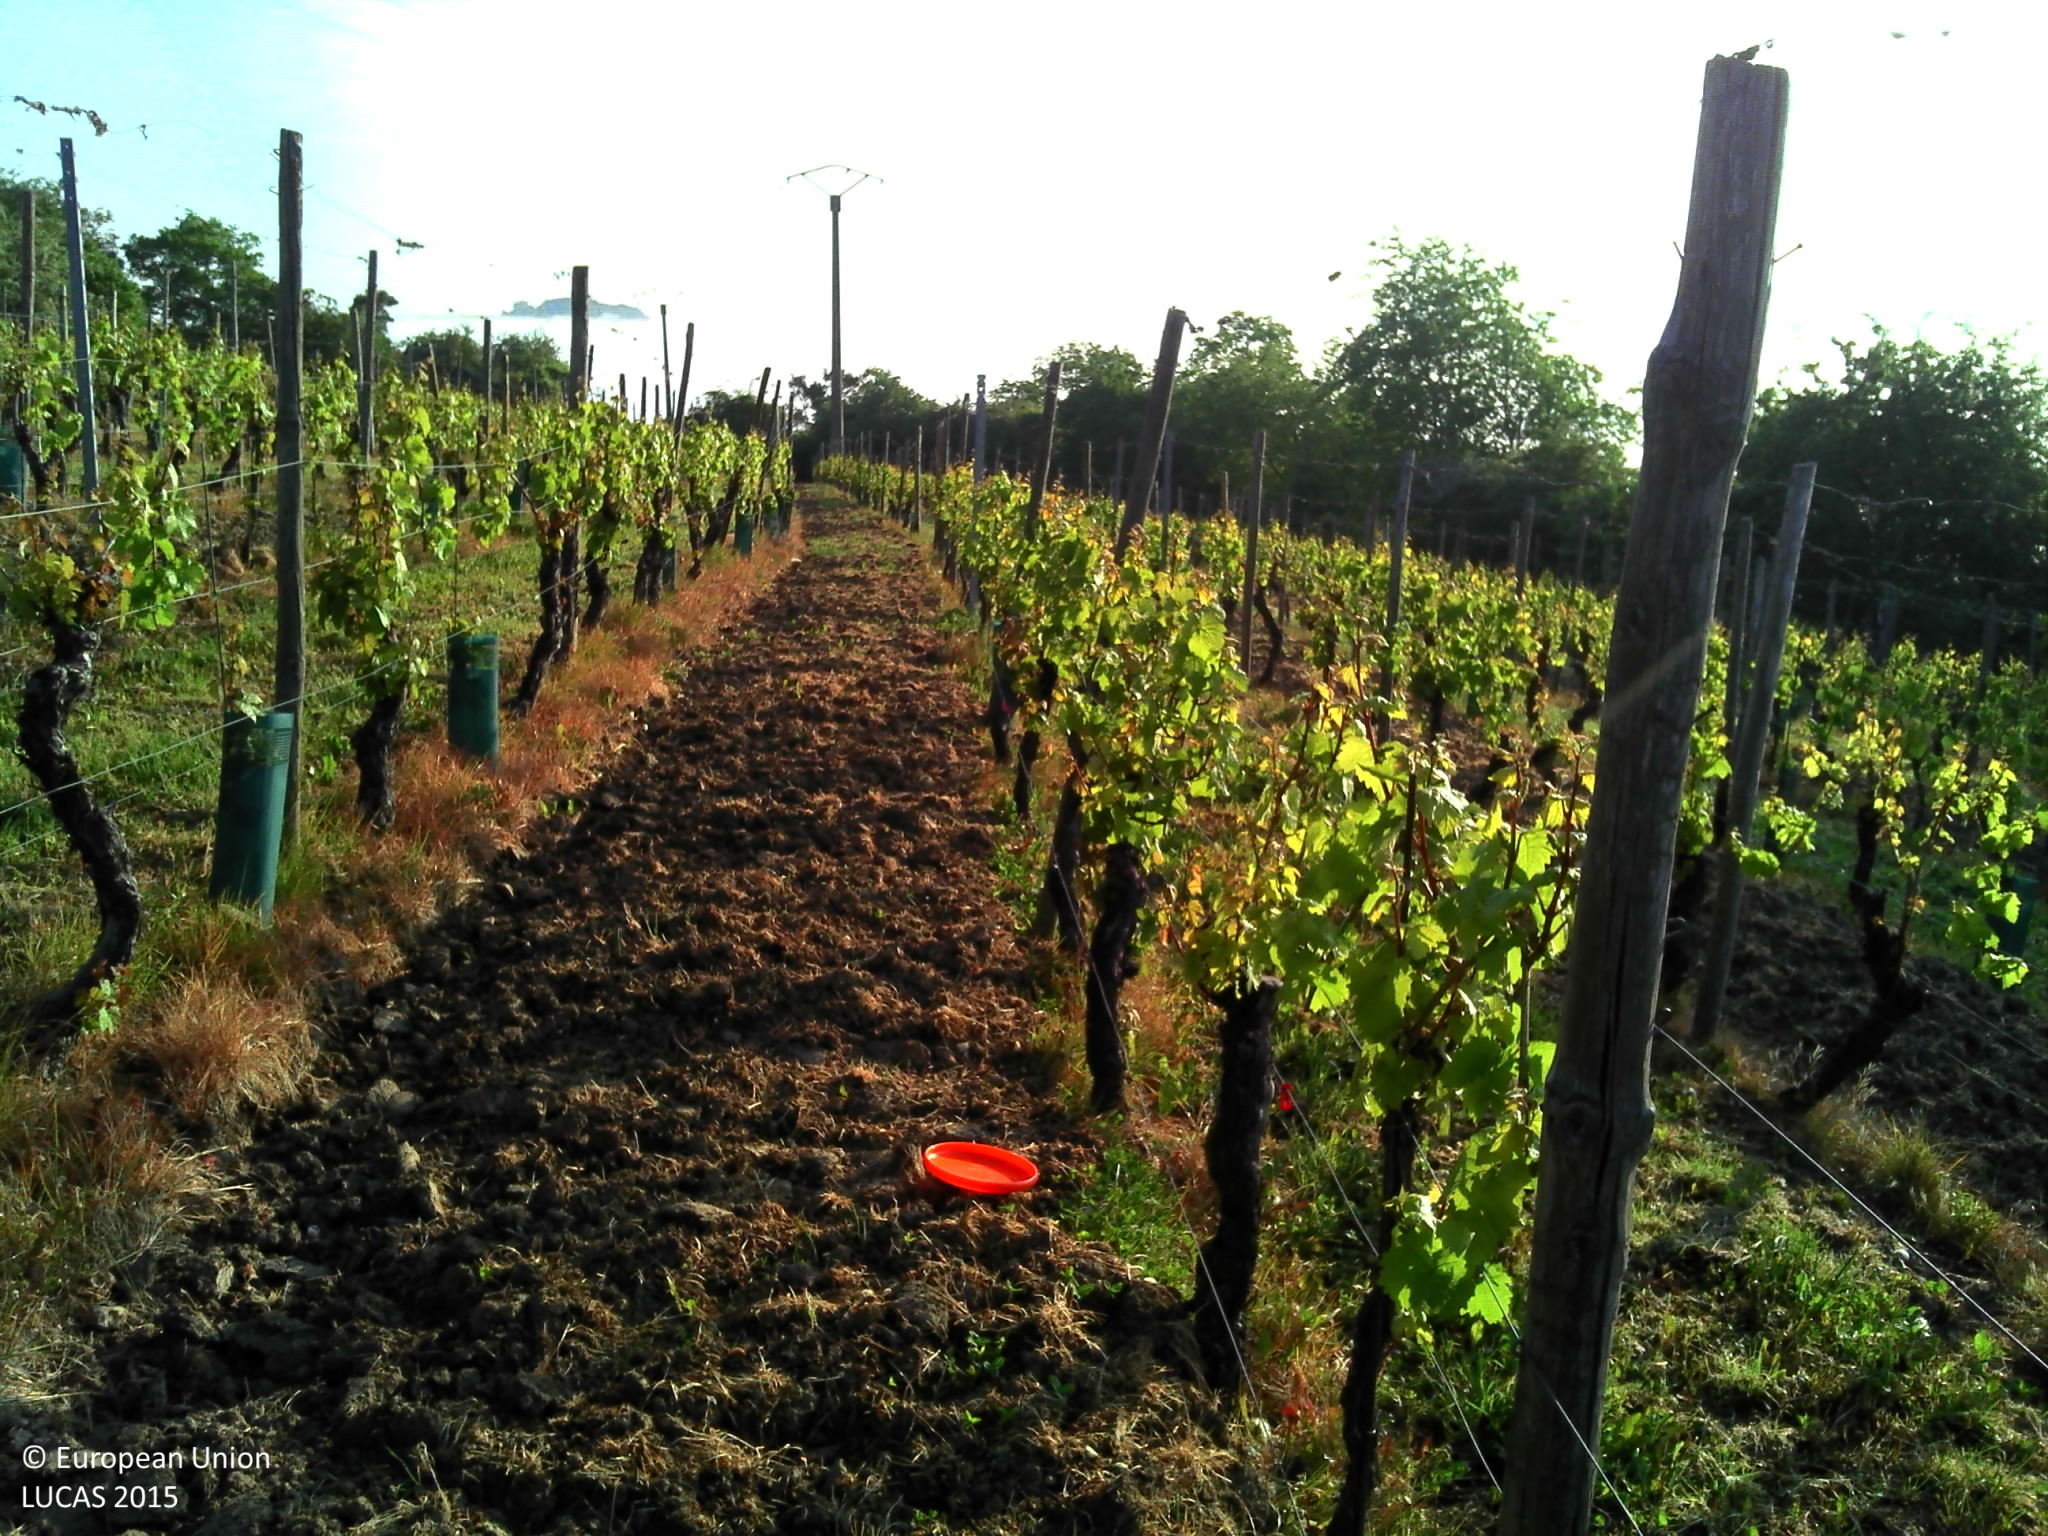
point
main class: Cropland
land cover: Vineyards
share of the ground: > 75 %
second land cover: Spontaneously vegetated surfaces
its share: 50 - 75 %
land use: Agriculture (excluding fallow land and kitchen gardens)
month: May
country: LU
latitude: 49.6239
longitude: 6.4144
